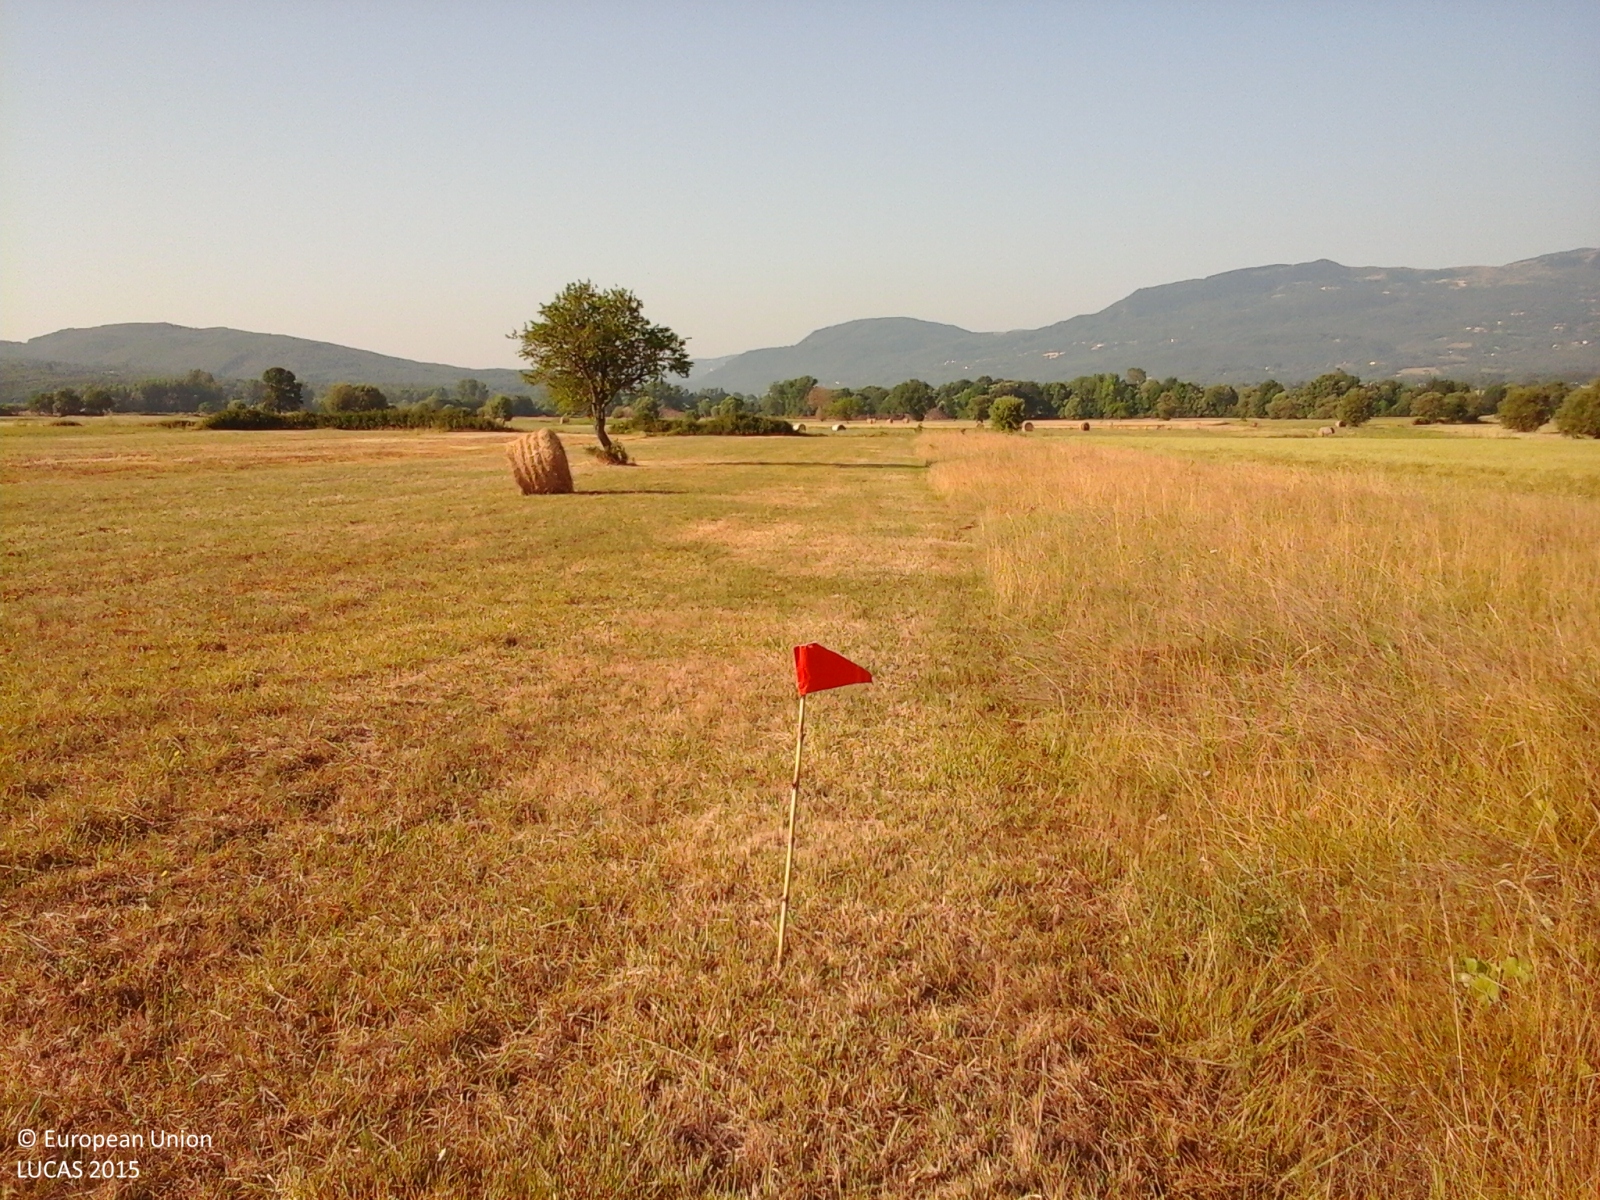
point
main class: Cropland
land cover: Temporary grasslands
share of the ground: > 75 %
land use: Agriculture (excluding fallow land and kitchen gardens)
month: July
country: IT
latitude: 41.4427
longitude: 14.6632
